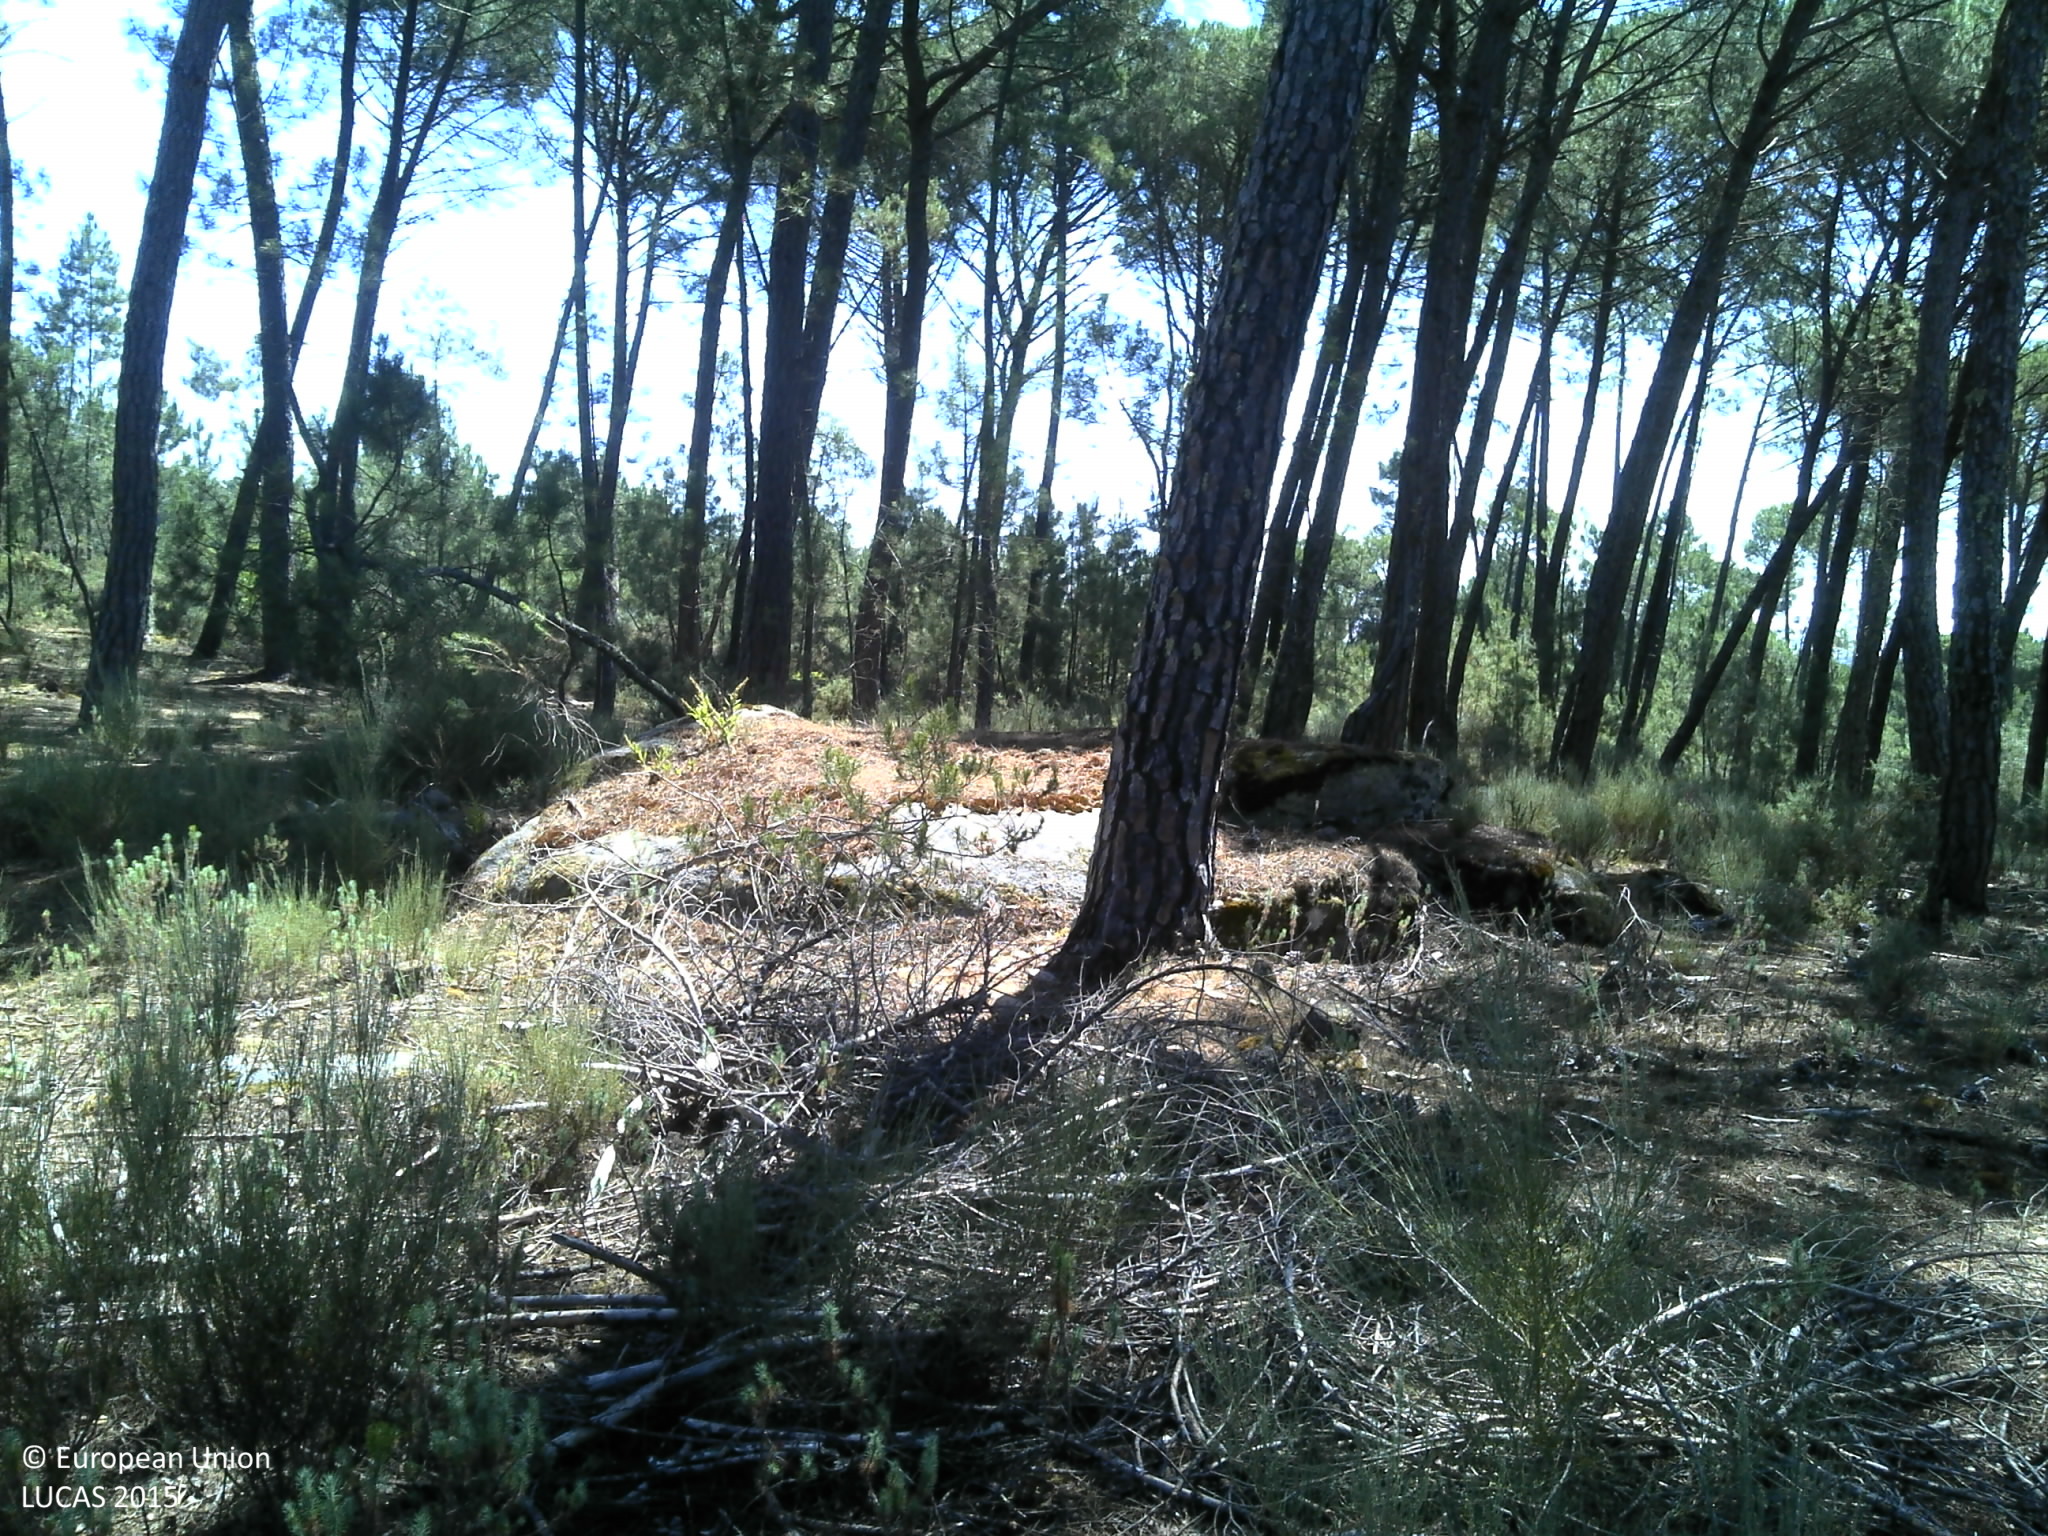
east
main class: Woodland
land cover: Pine dominated coniferous woodland
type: coniferous forest of the mediterranean region
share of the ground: 50 - 75 %
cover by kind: coniferous forest trees 70 %, shrubs 25 %, herbaceous plants 5 %
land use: Forestry
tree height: > 5 m
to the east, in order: Pine dominated coniferous woodland; Rocks and stones; Pine dominated coniferous woodland; Tracks; Pine dominated coniferous woodland; Shrubland without tree cover; Tracks; Pine dominated coniferous woodland; Ditches and canals; Pine dominated coniferous woodland; Shrubland with sparse tree cover
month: June
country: PT
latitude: 40.5729
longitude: -7.8520
